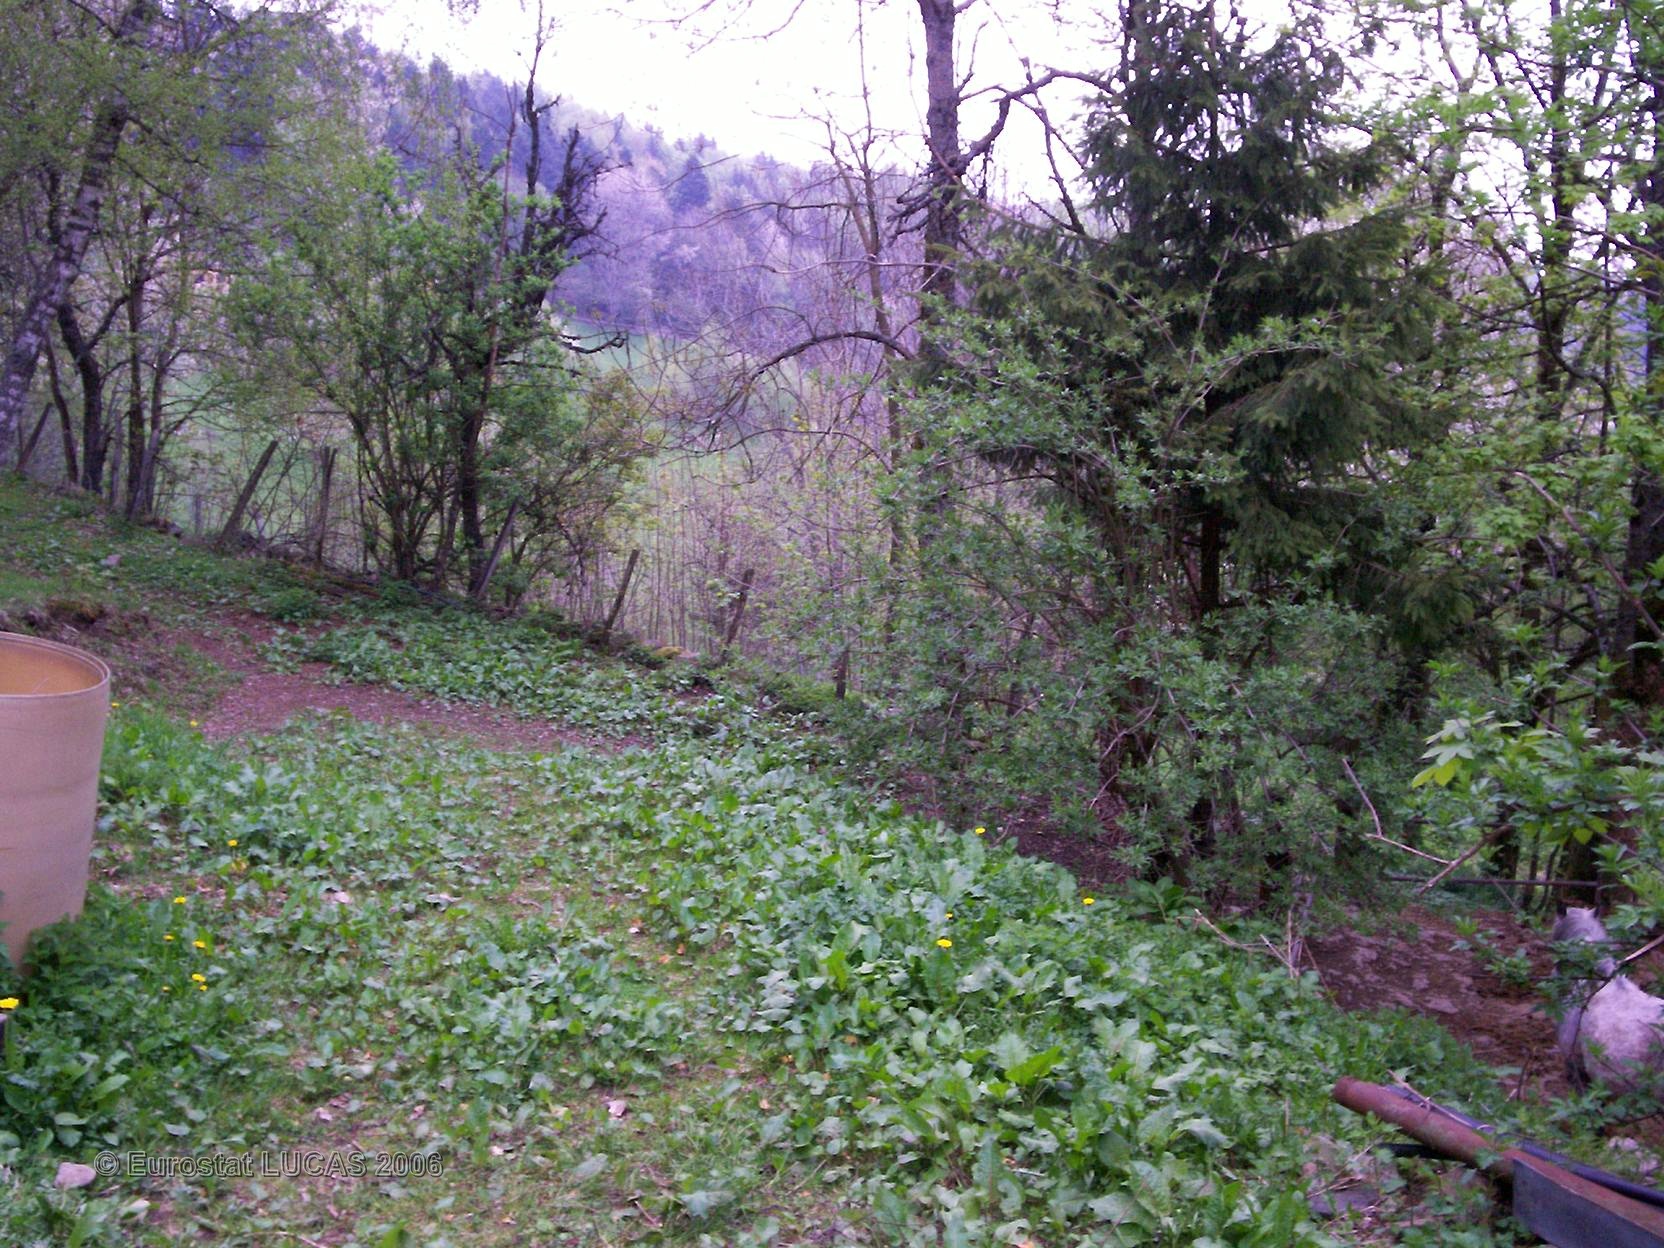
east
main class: Grassland
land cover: Grassland with sparse tree/shrub cover
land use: Agriculture (excluding fallow land and kitchen gardens)
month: May
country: FR
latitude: 47.9512
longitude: 7.0956
